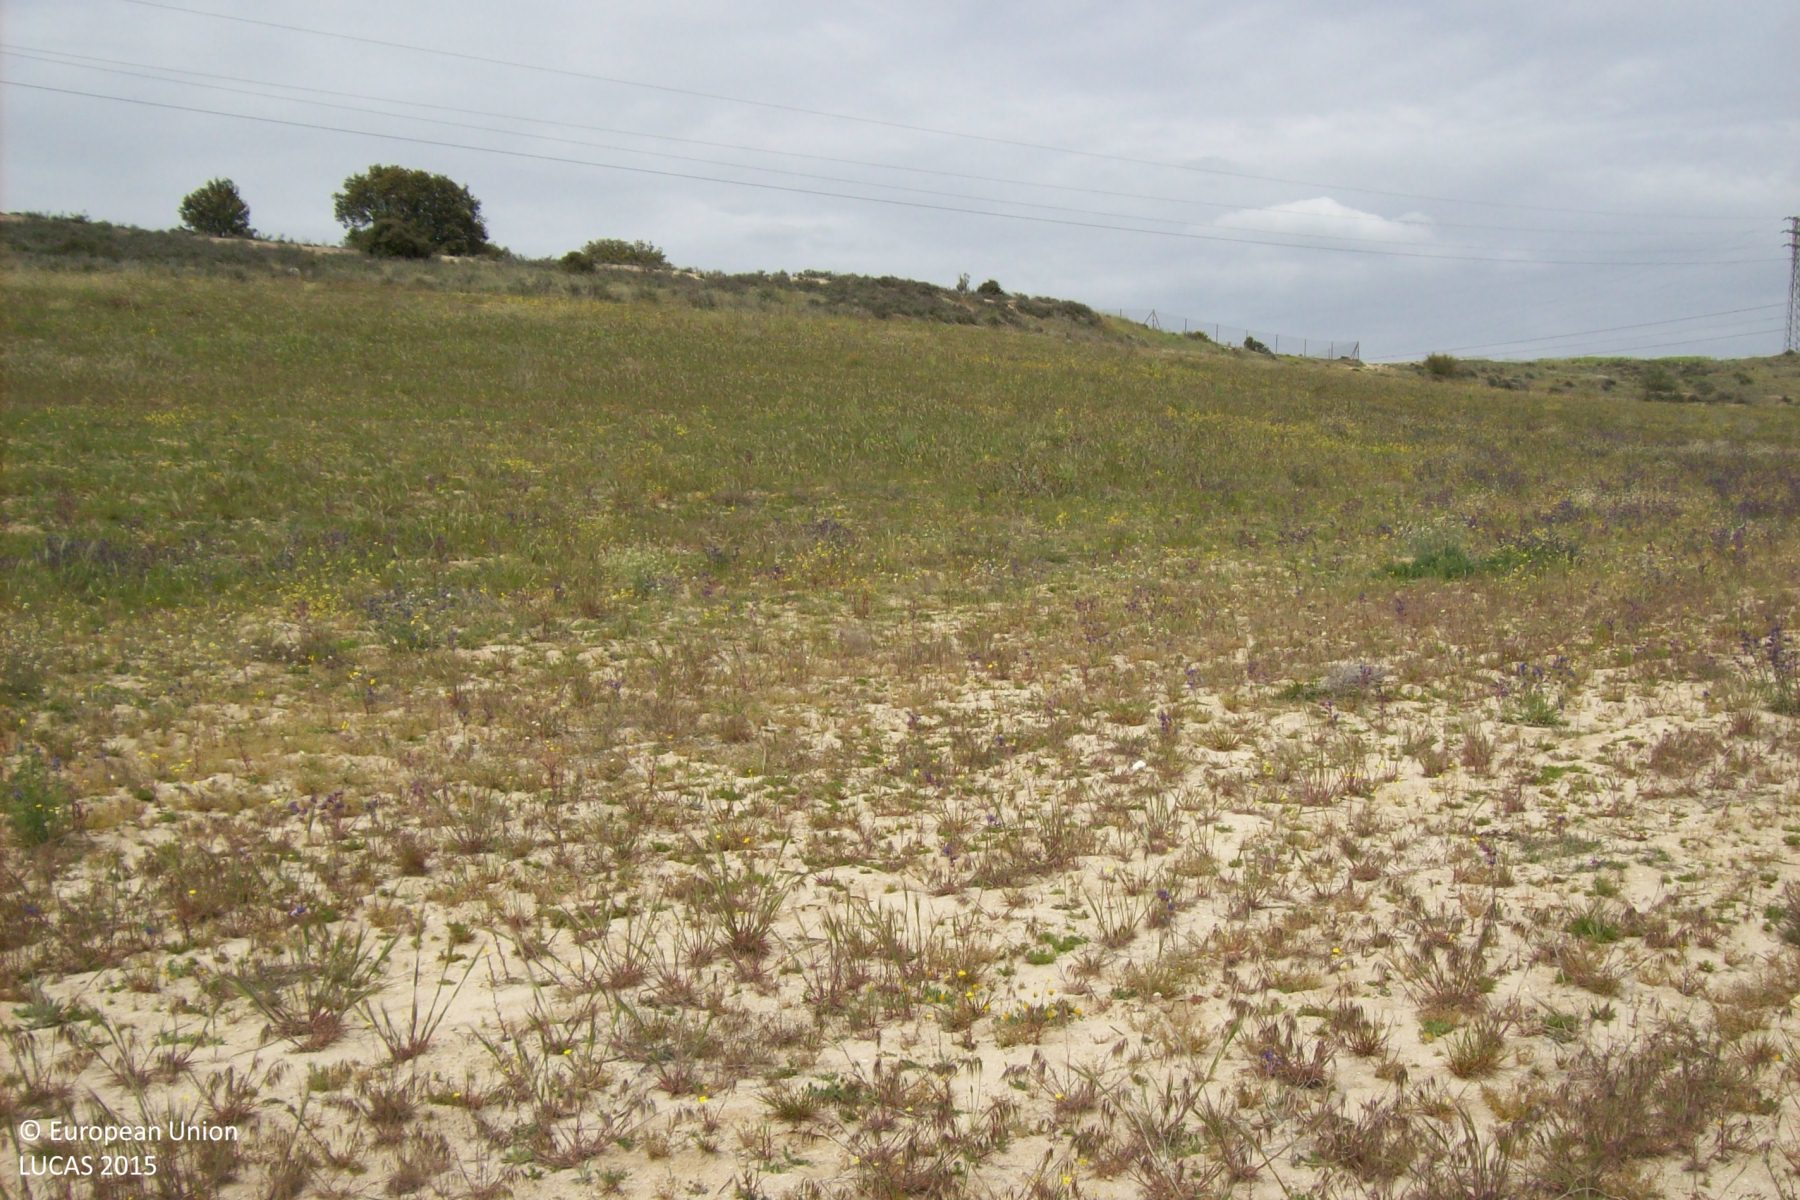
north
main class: Grassland
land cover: Spontaneously vegetated surfaces
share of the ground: 50 - 75 %
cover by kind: herbaceous plants 60 %, unconsolidated bare surface 40 %
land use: Abandoned areas
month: April
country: ES
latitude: 40.4639
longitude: -3.8981
